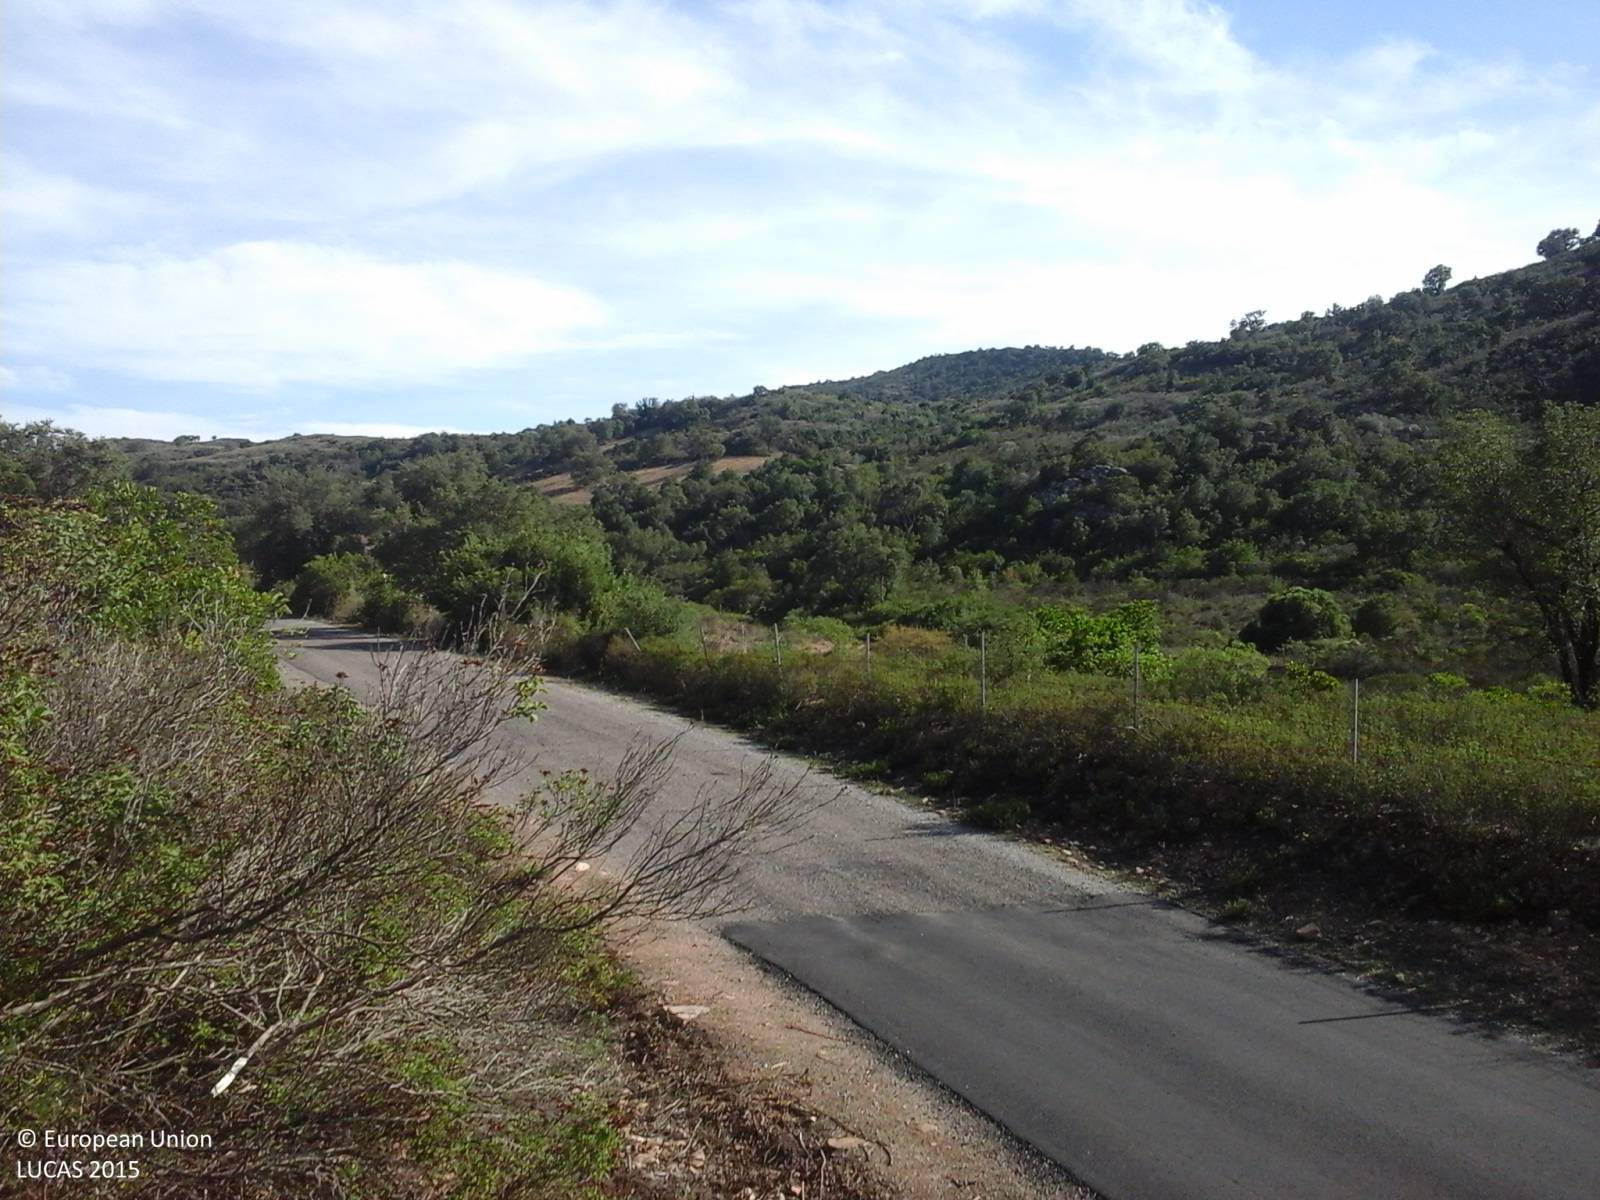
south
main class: Shrubland
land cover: Shrubland without tree cover
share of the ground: > 75 %
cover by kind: unconsolidated bare surface 45 %, shrubs 35 %, herbaceous plants 15 %, consolidated bare surface 5 %
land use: Agriculture (excluding fallow land and kitchen gardens)
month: September
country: IT
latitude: 39.9045
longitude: 9.6161
